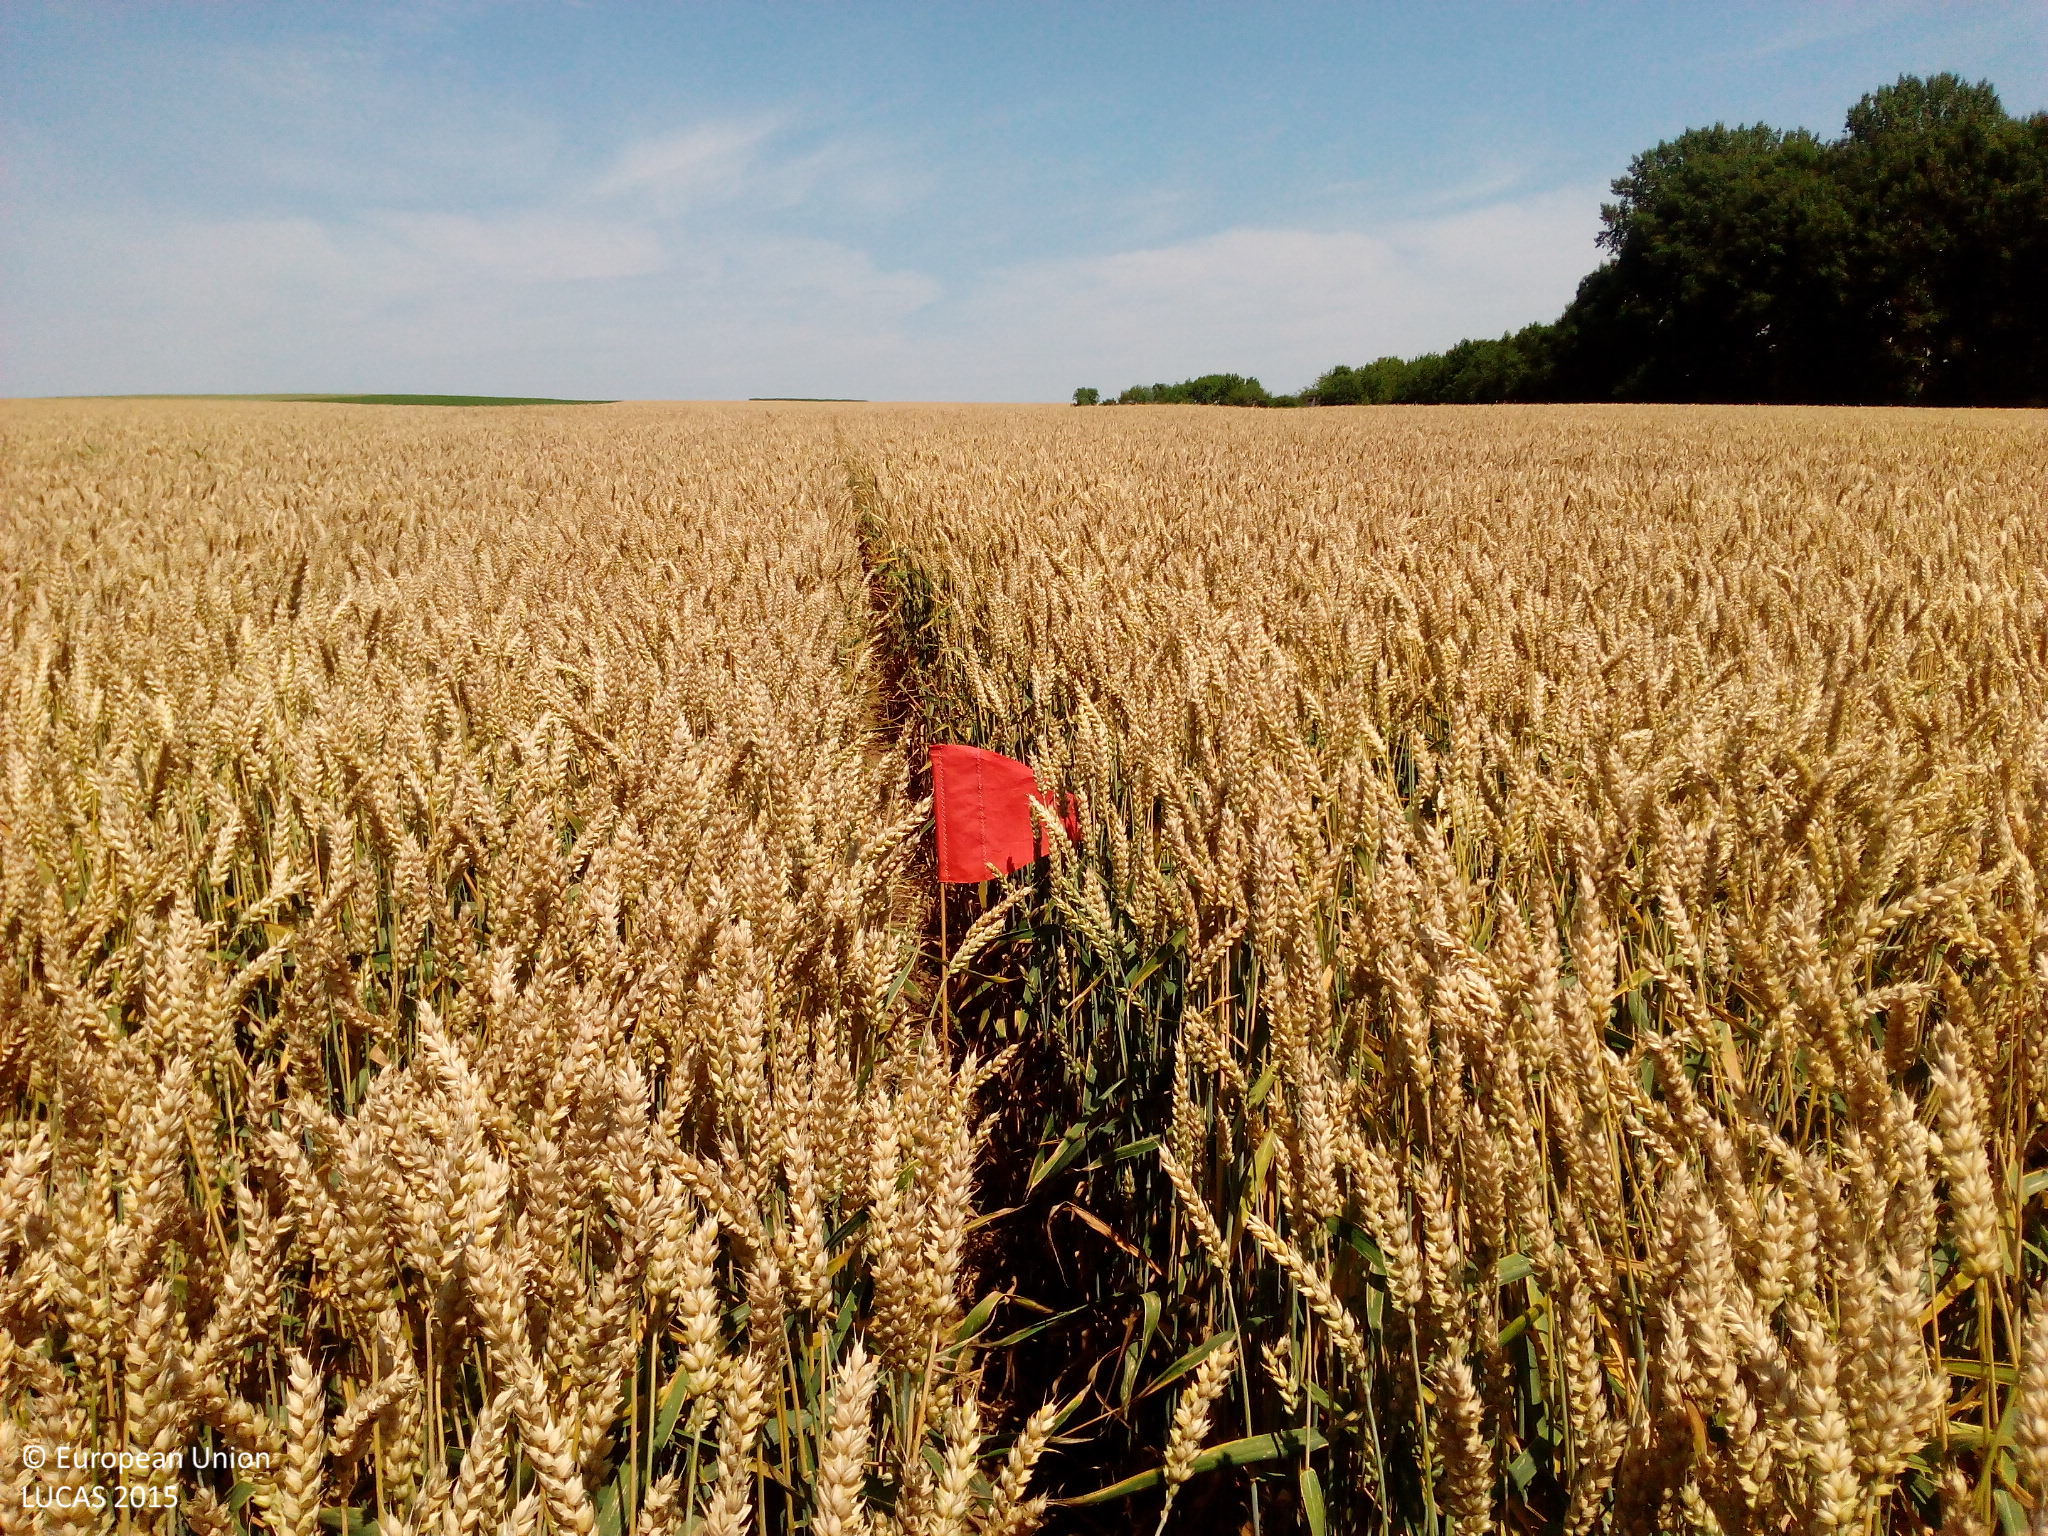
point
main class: Cropland
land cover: Common wheat
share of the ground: > 75 %
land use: Agriculture (excluding fallow land and kitchen gardens)
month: July
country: DE
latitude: 49.6267
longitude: 9.9585
